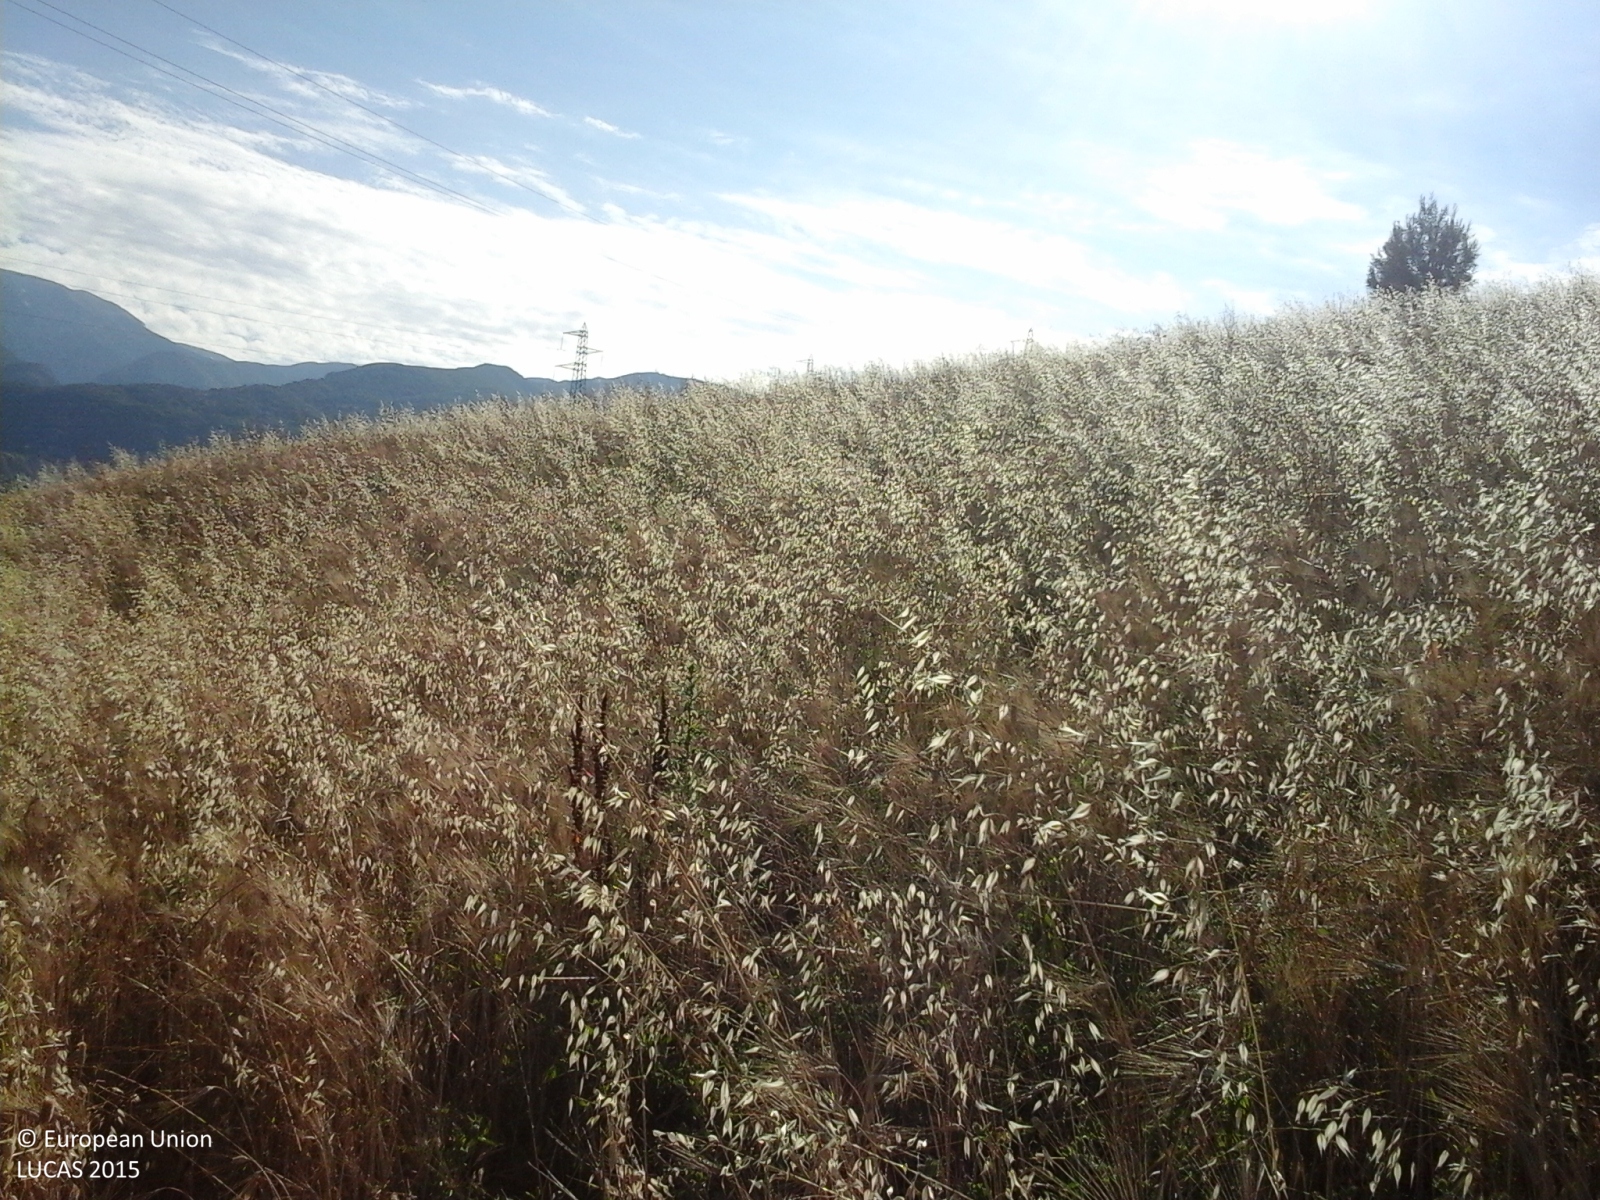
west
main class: Cropland
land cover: Durum wheat
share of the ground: > 75 %
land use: Agriculture (excluding fallow land and kitchen gardens)
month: June
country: IT
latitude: 42.1856
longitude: 14.2366
